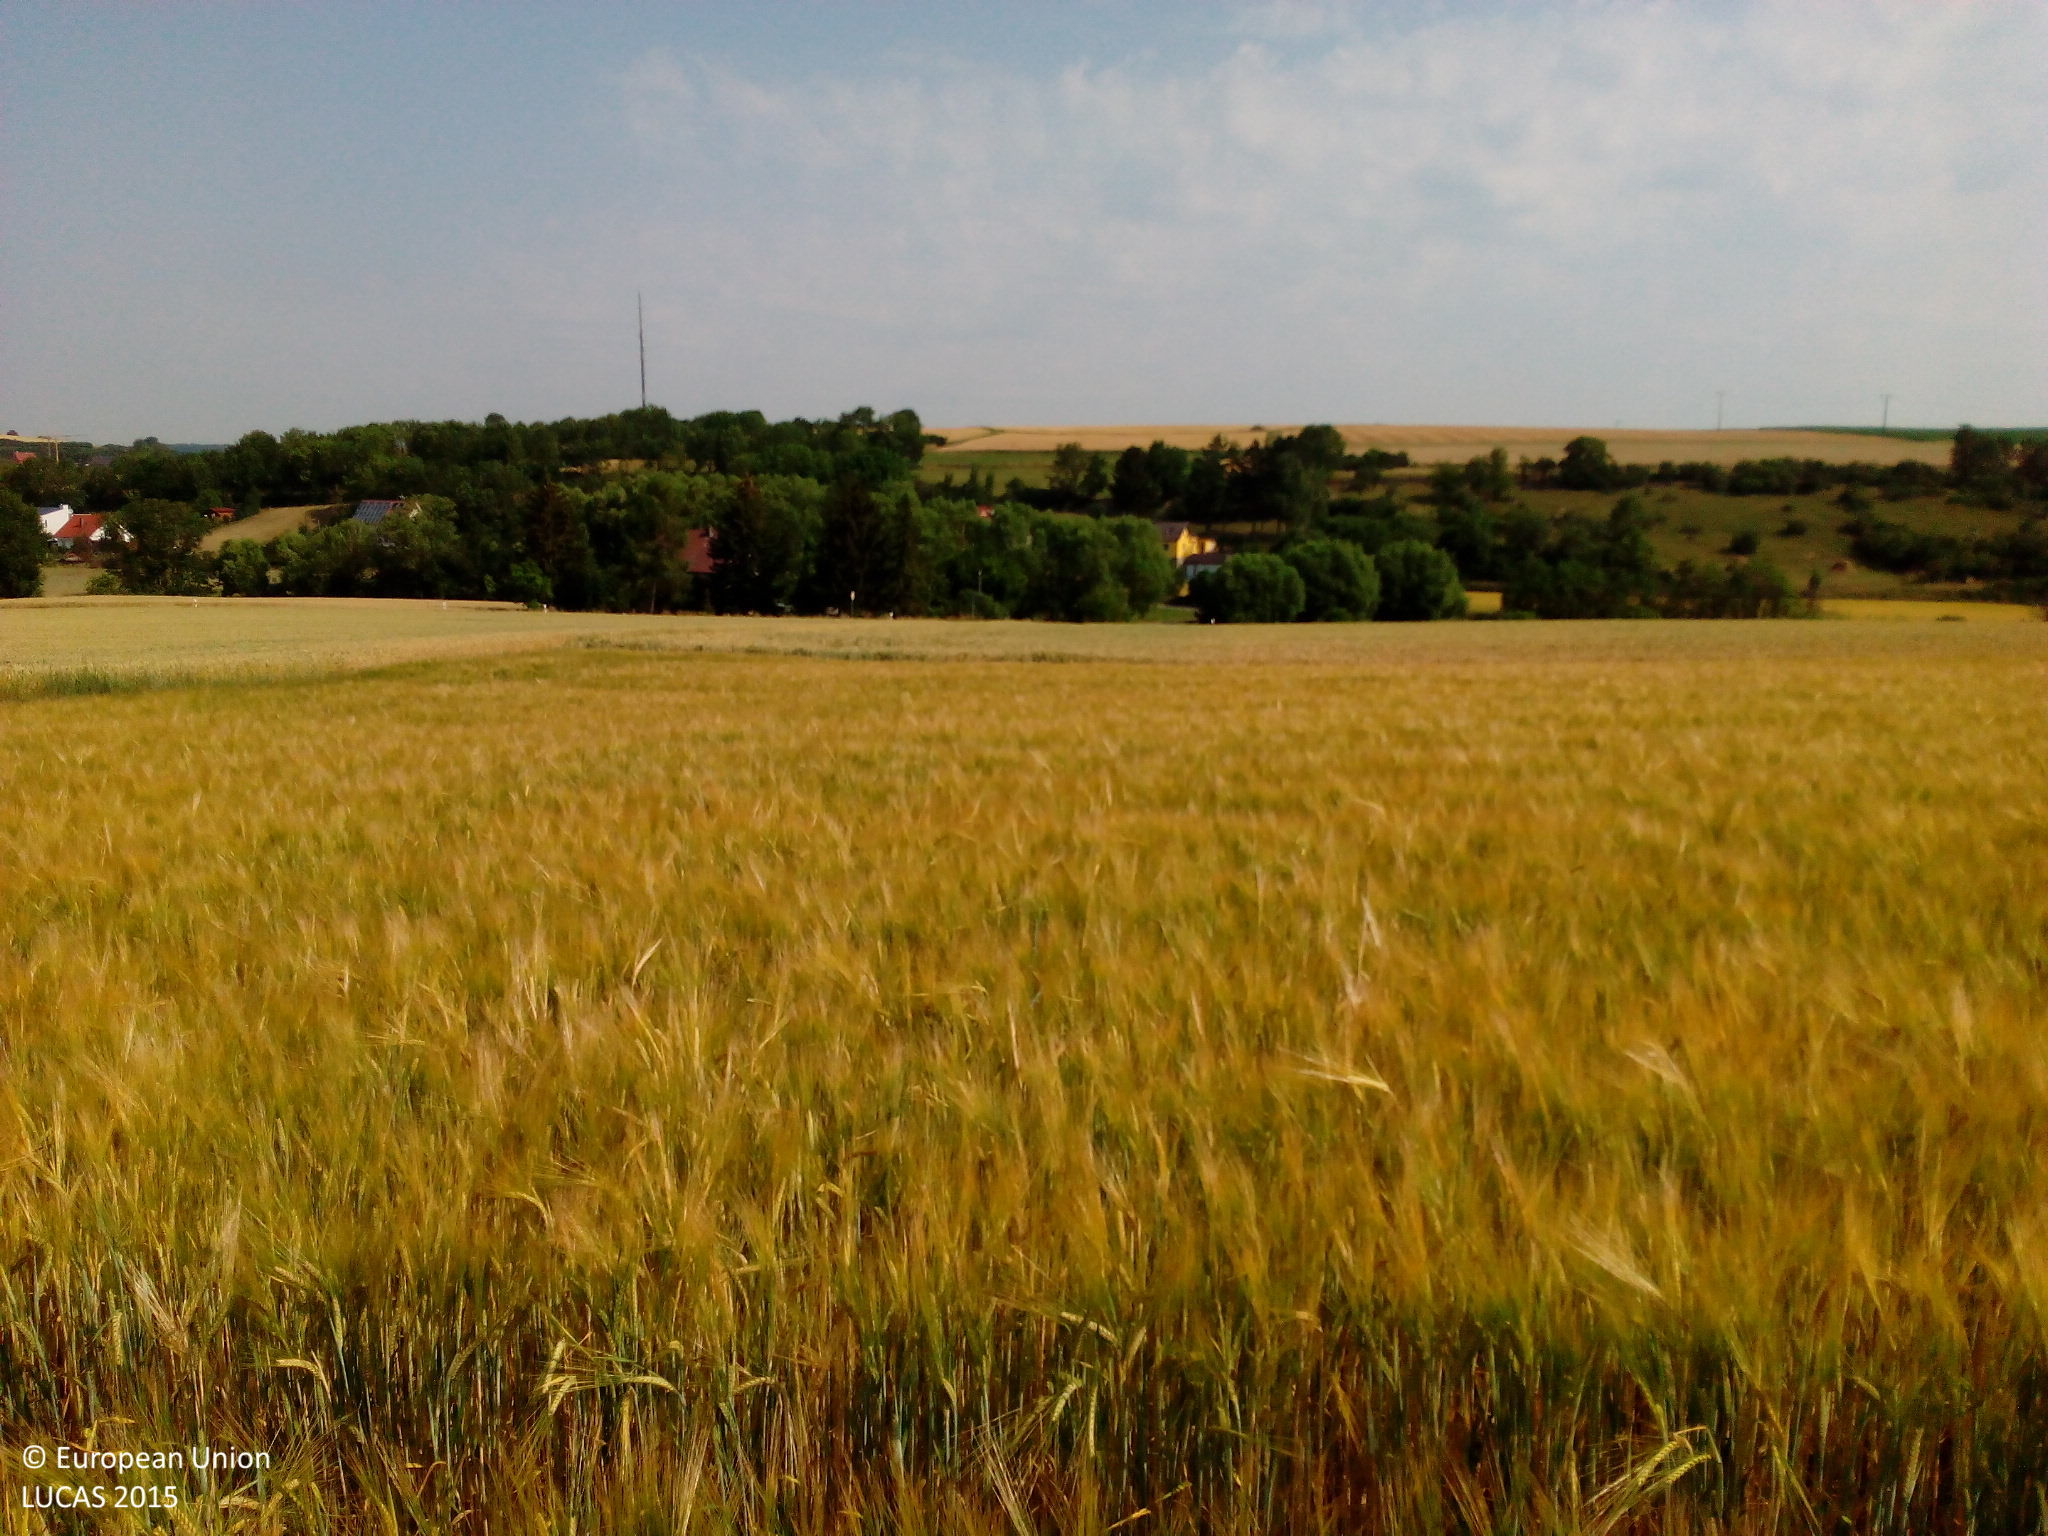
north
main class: Cropland
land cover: Barley
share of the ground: > 75 %
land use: Agriculture (excluding fallow land and kitchen gardens)
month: July
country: DE
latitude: 49.6086
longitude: 9.8478
